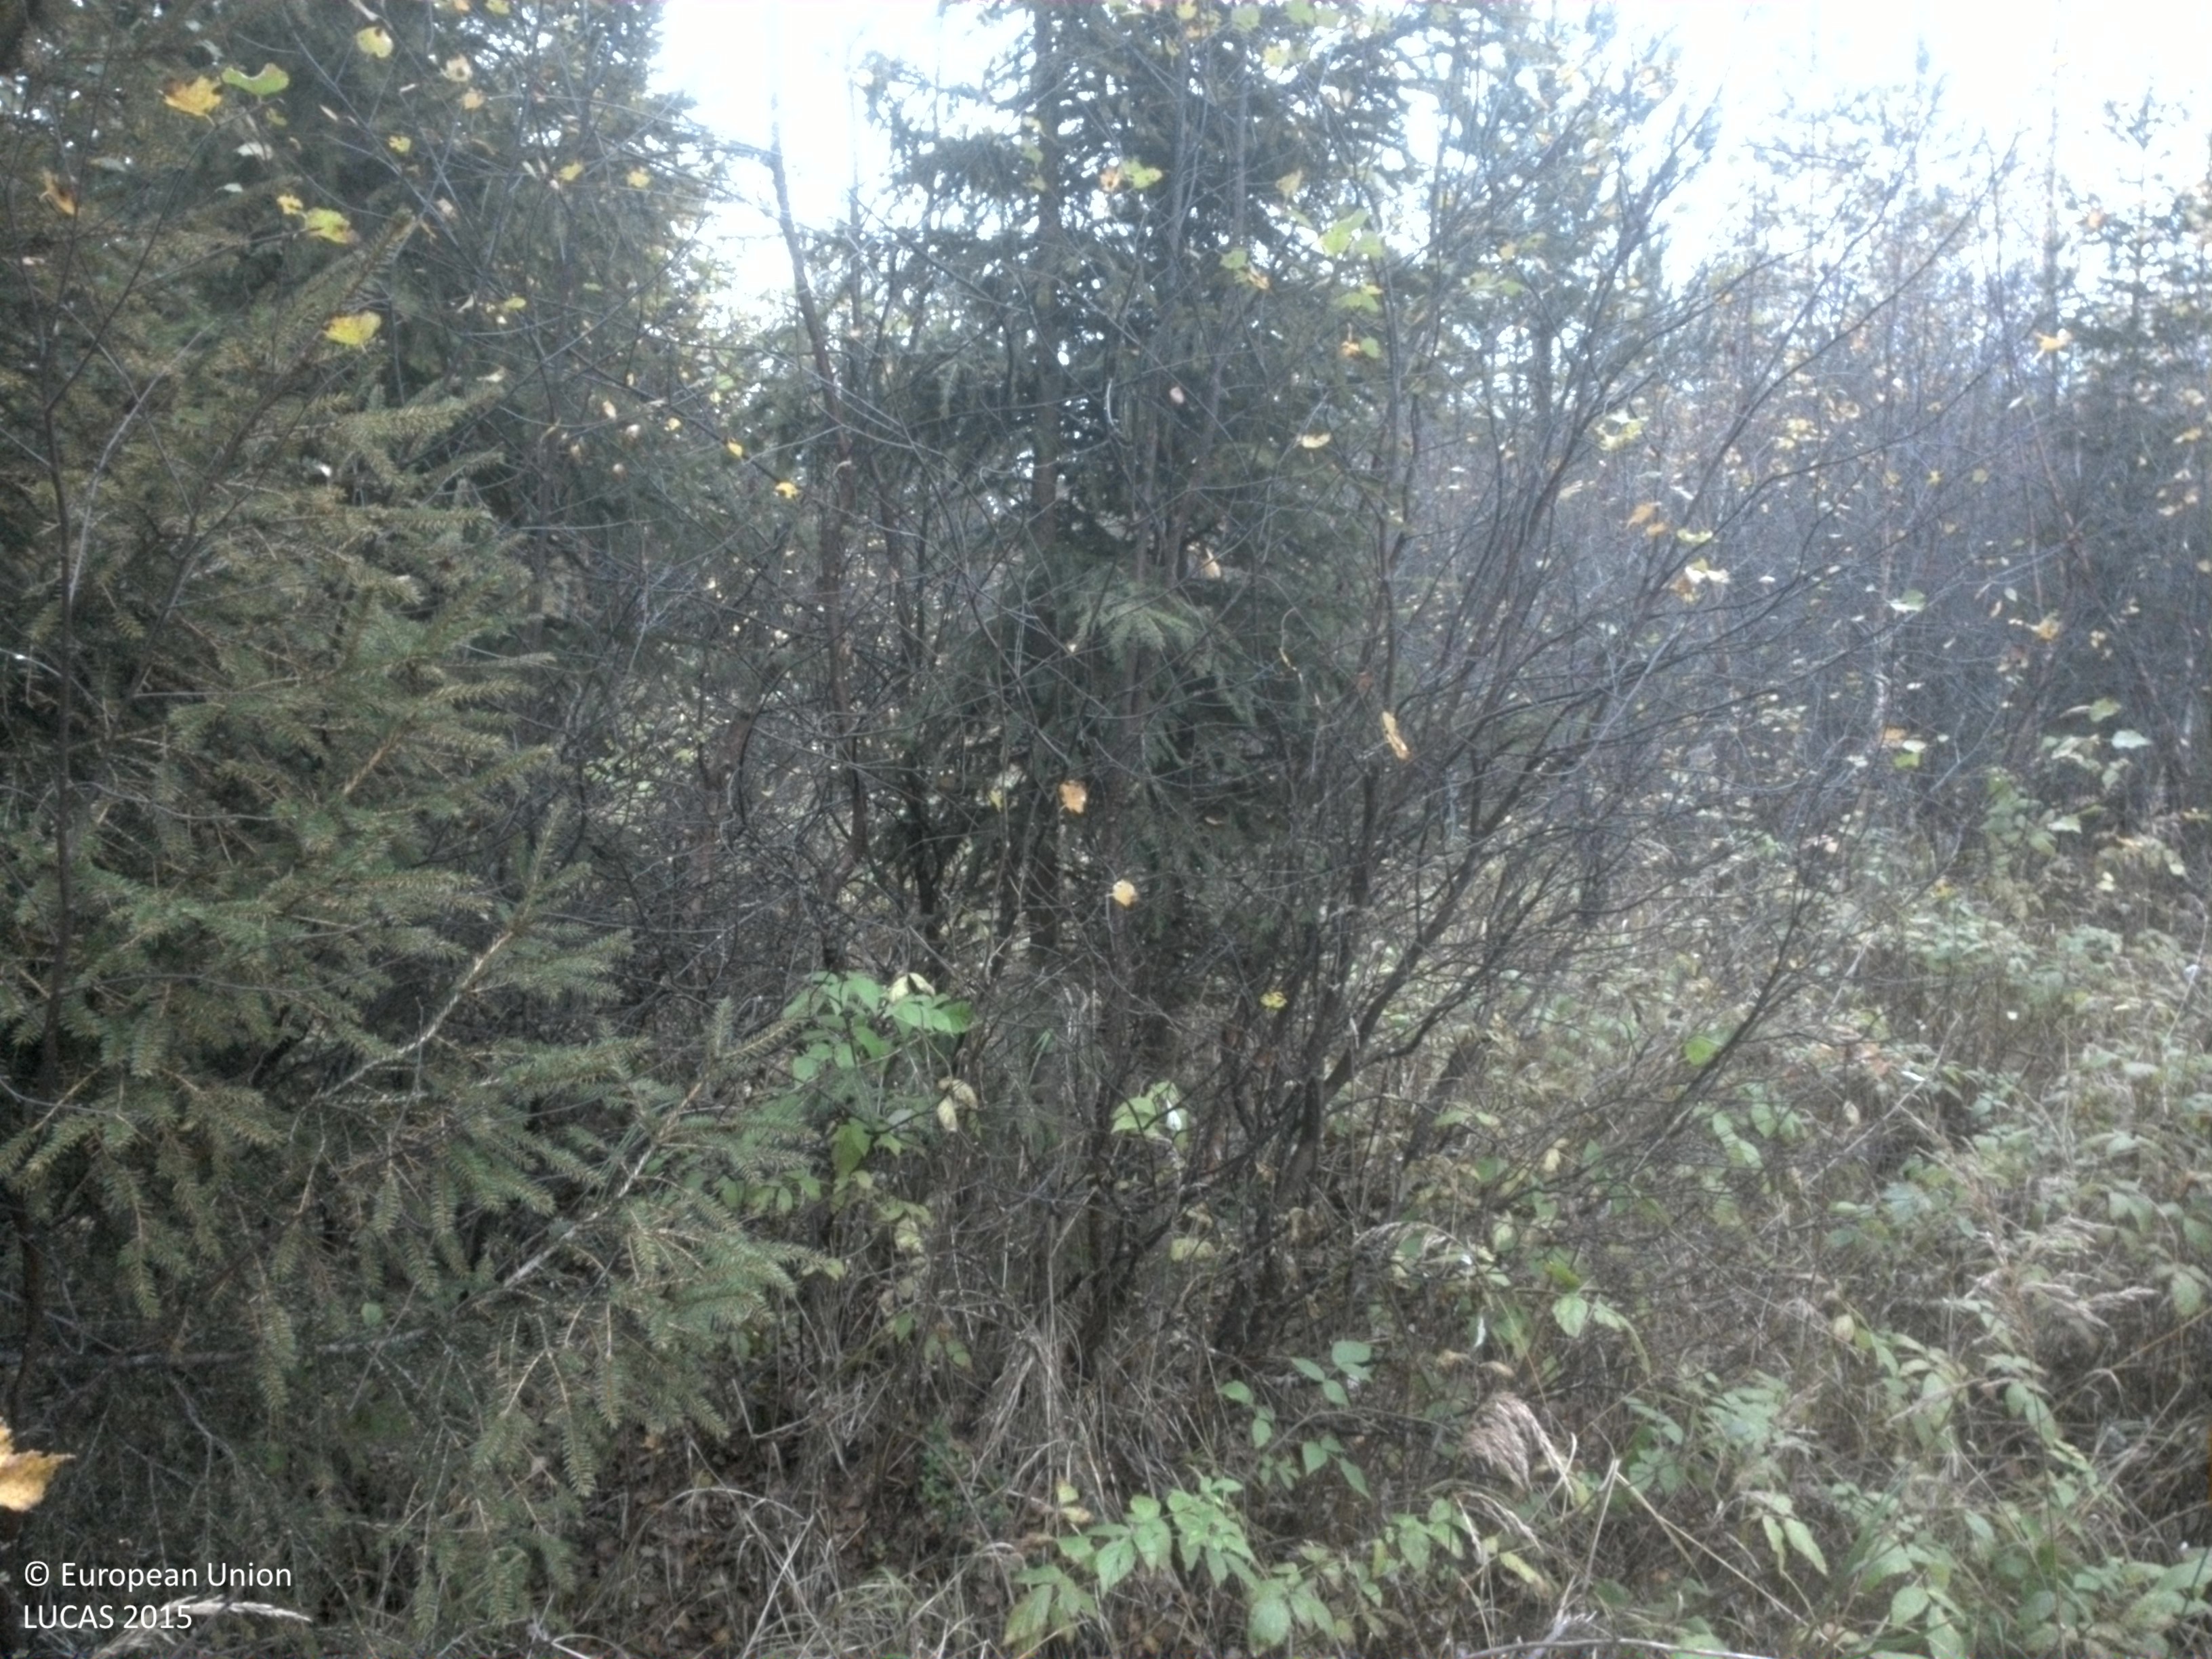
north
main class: Woodland
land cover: Other mixed woodland
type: boreal forest
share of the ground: 25 - 50 %
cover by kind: herbaceous plants 35 %, coniferous forest trees 25 %, broadleaved forest trees 20 %, shrubs 20 %
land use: Forestry
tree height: < 5 m
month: October
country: SE
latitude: 64.0918
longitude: 19.8437
